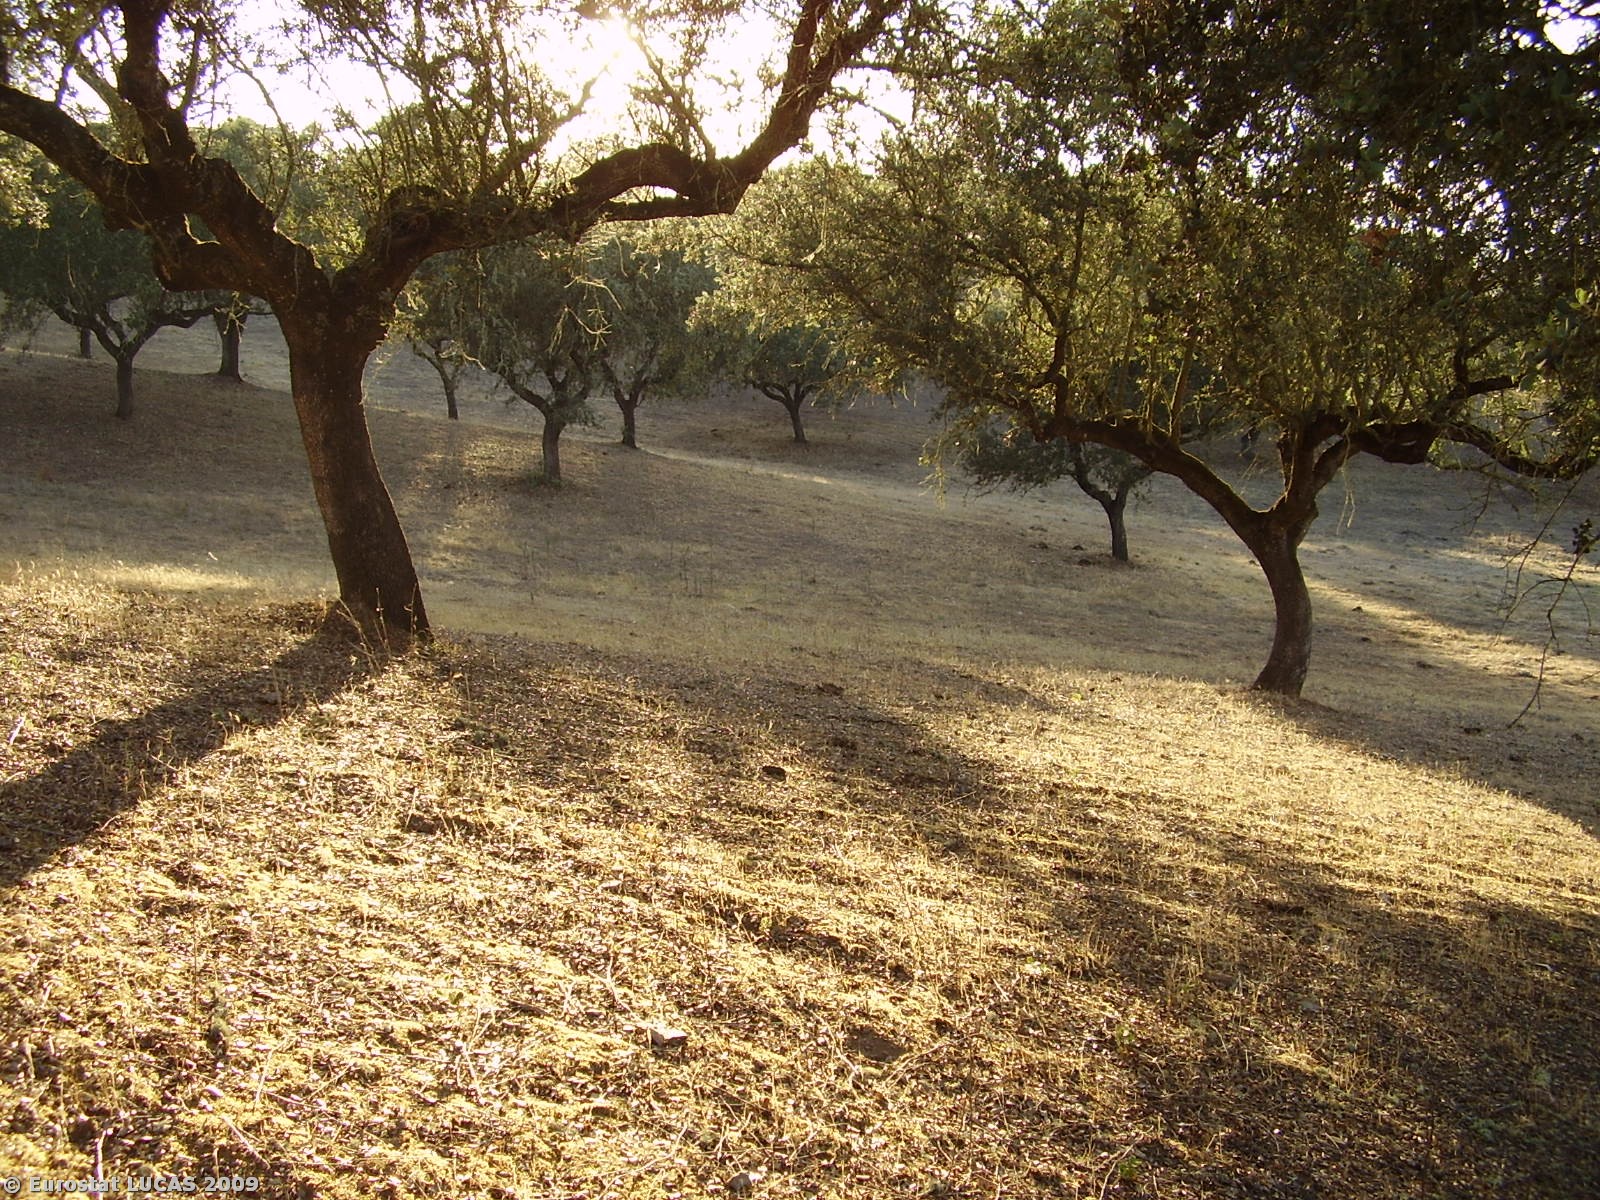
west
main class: Woodland
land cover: Broadleaved woodland
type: broadleaved evergreen forest
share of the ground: 10 - 25 %
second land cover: Spontaneously vegetated surfaces
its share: 10 - 25 %
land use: Forestry
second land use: Fallow land
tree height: > 5 m
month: July
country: PT
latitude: 38.4819
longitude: -7.6746
